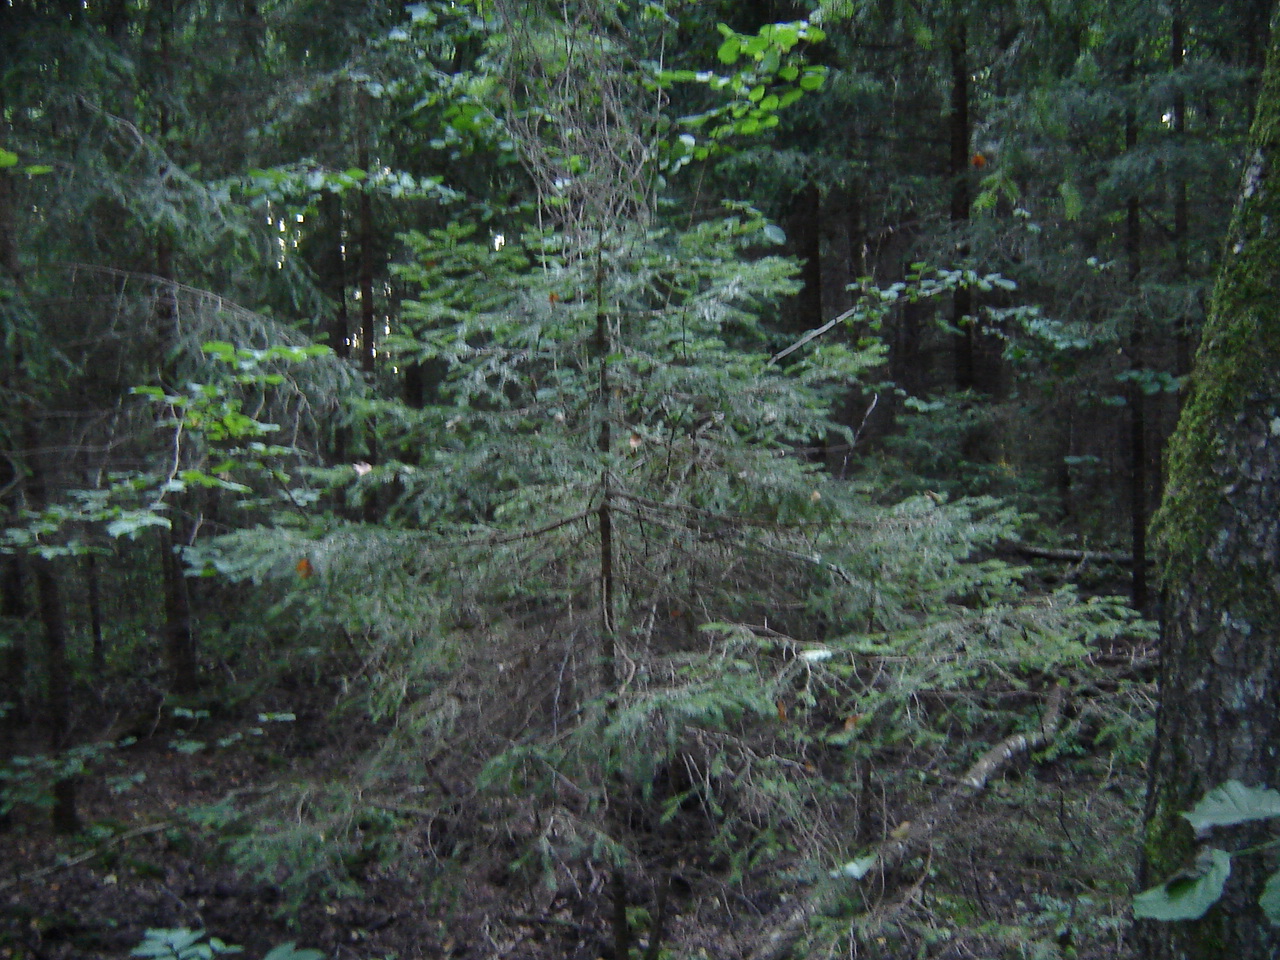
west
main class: Woodland
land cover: Other mixed woodland
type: hemiboreal forest and nemoral coniferous forest and mixed broadleaved-coniferous forest
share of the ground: > 75 %
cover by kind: broadleaved forest trees 50 %, coniferous forest trees 45 %, lichens and mosses 5 %
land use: Forestry
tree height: > 5 m
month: August
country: LT
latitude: 55.0528
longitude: 25.0640
